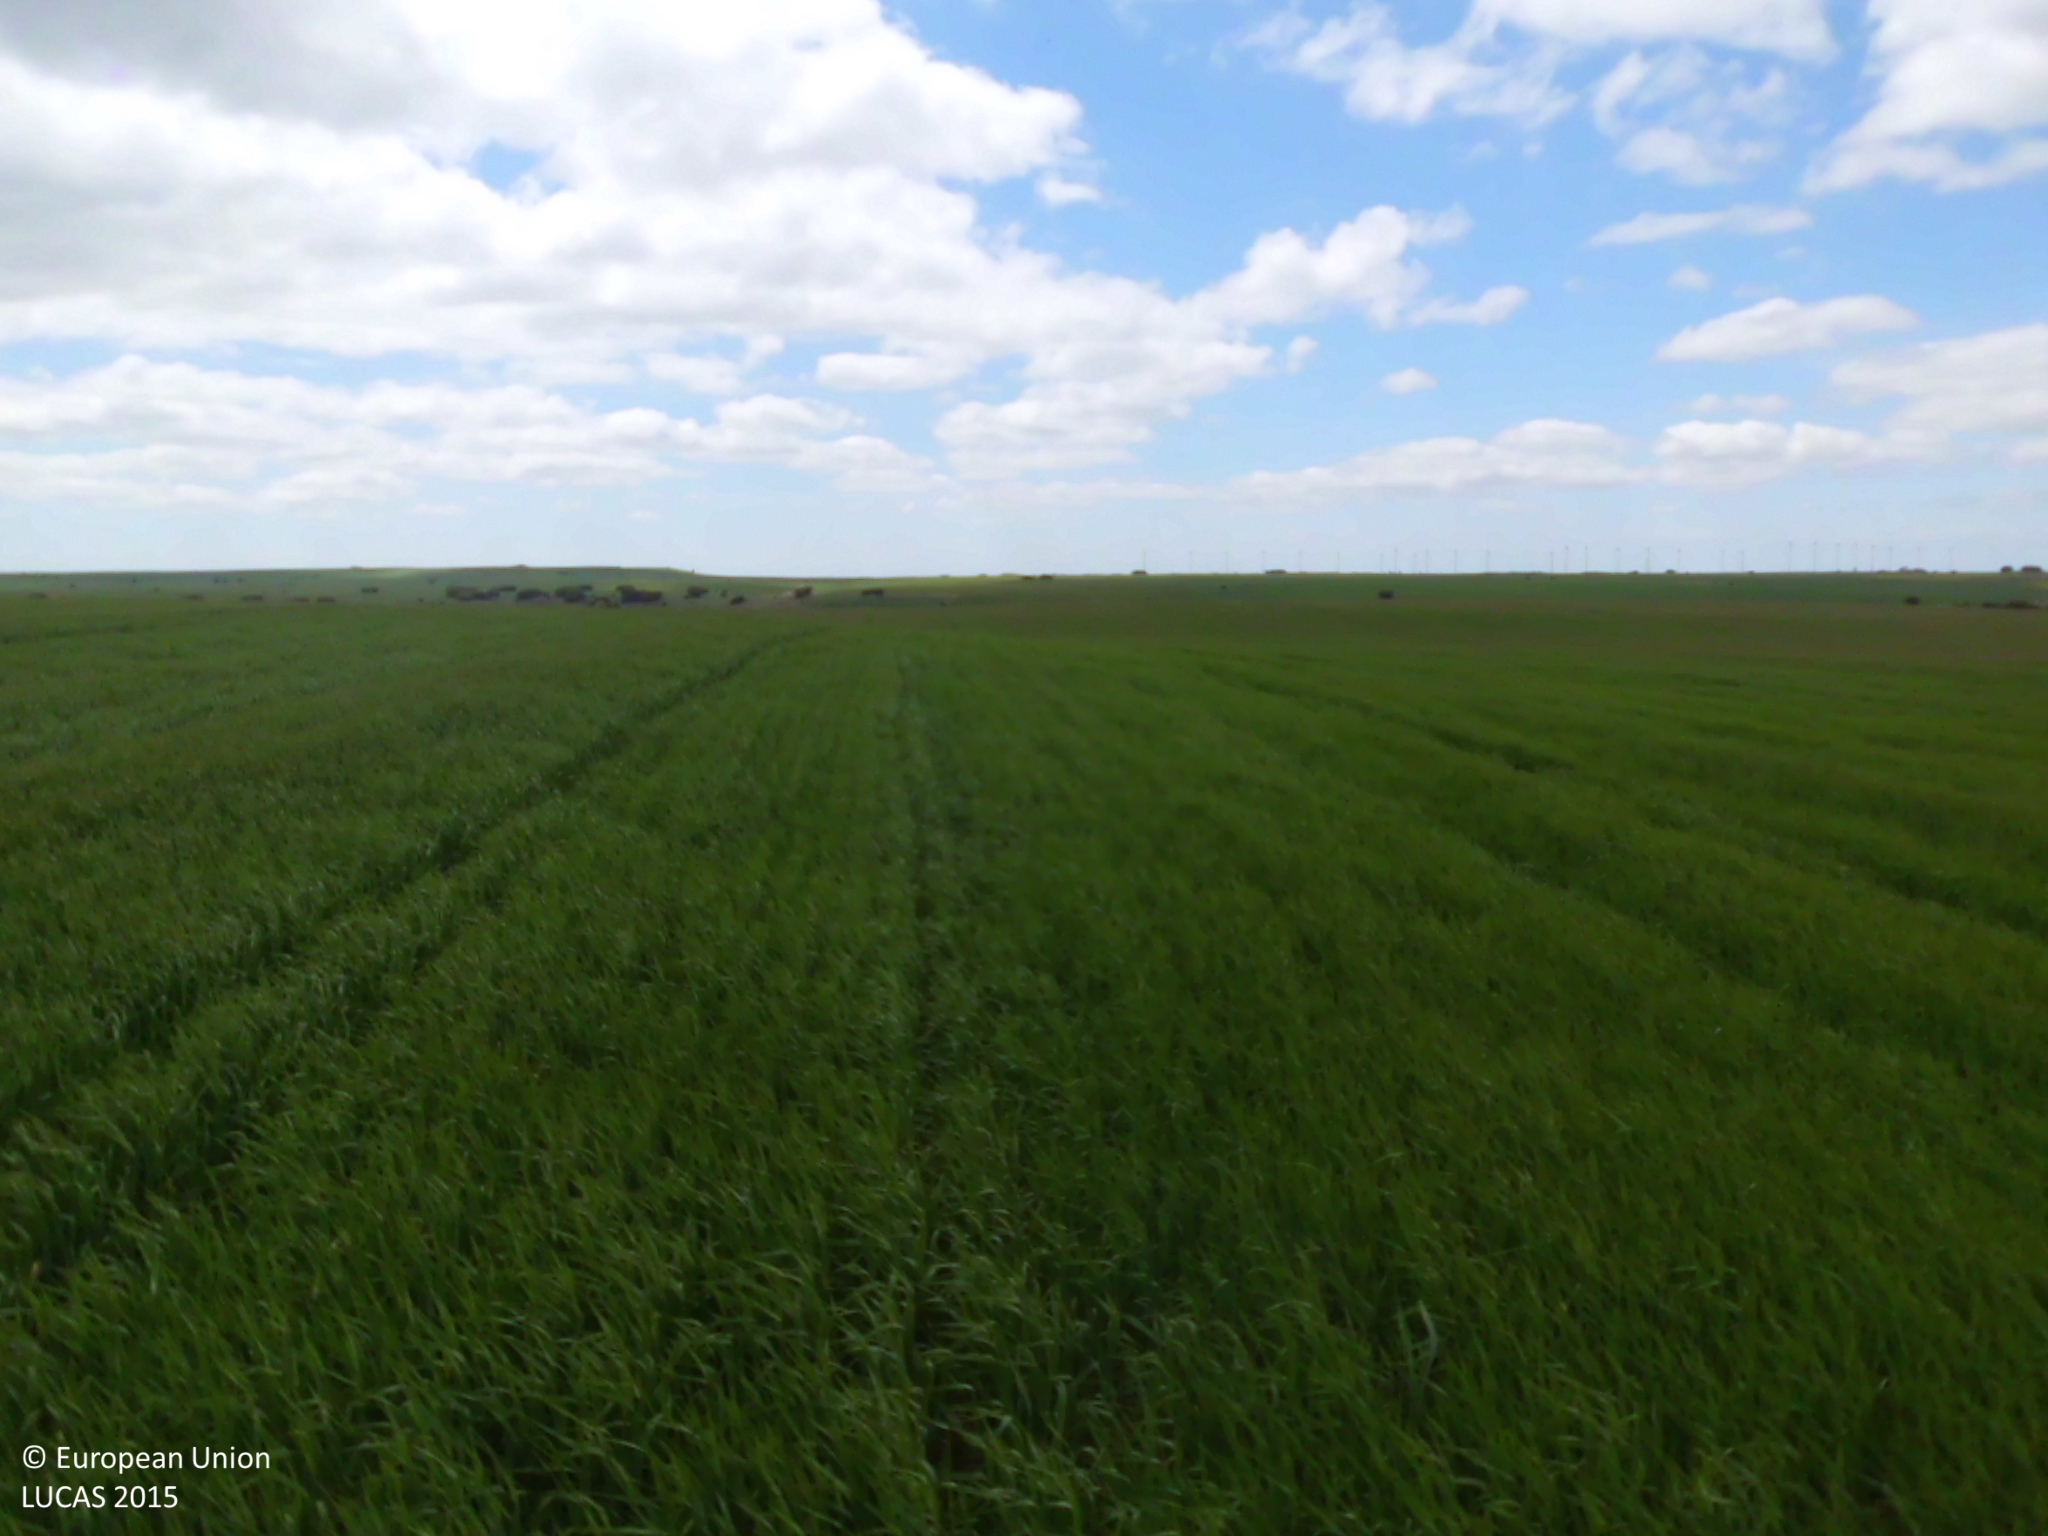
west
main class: Cropland
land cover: Barley
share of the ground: > 75 %
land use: Agriculture (excluding fallow land and kitchen gardens)
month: May
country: ES
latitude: 42.3193
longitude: -3.9820
